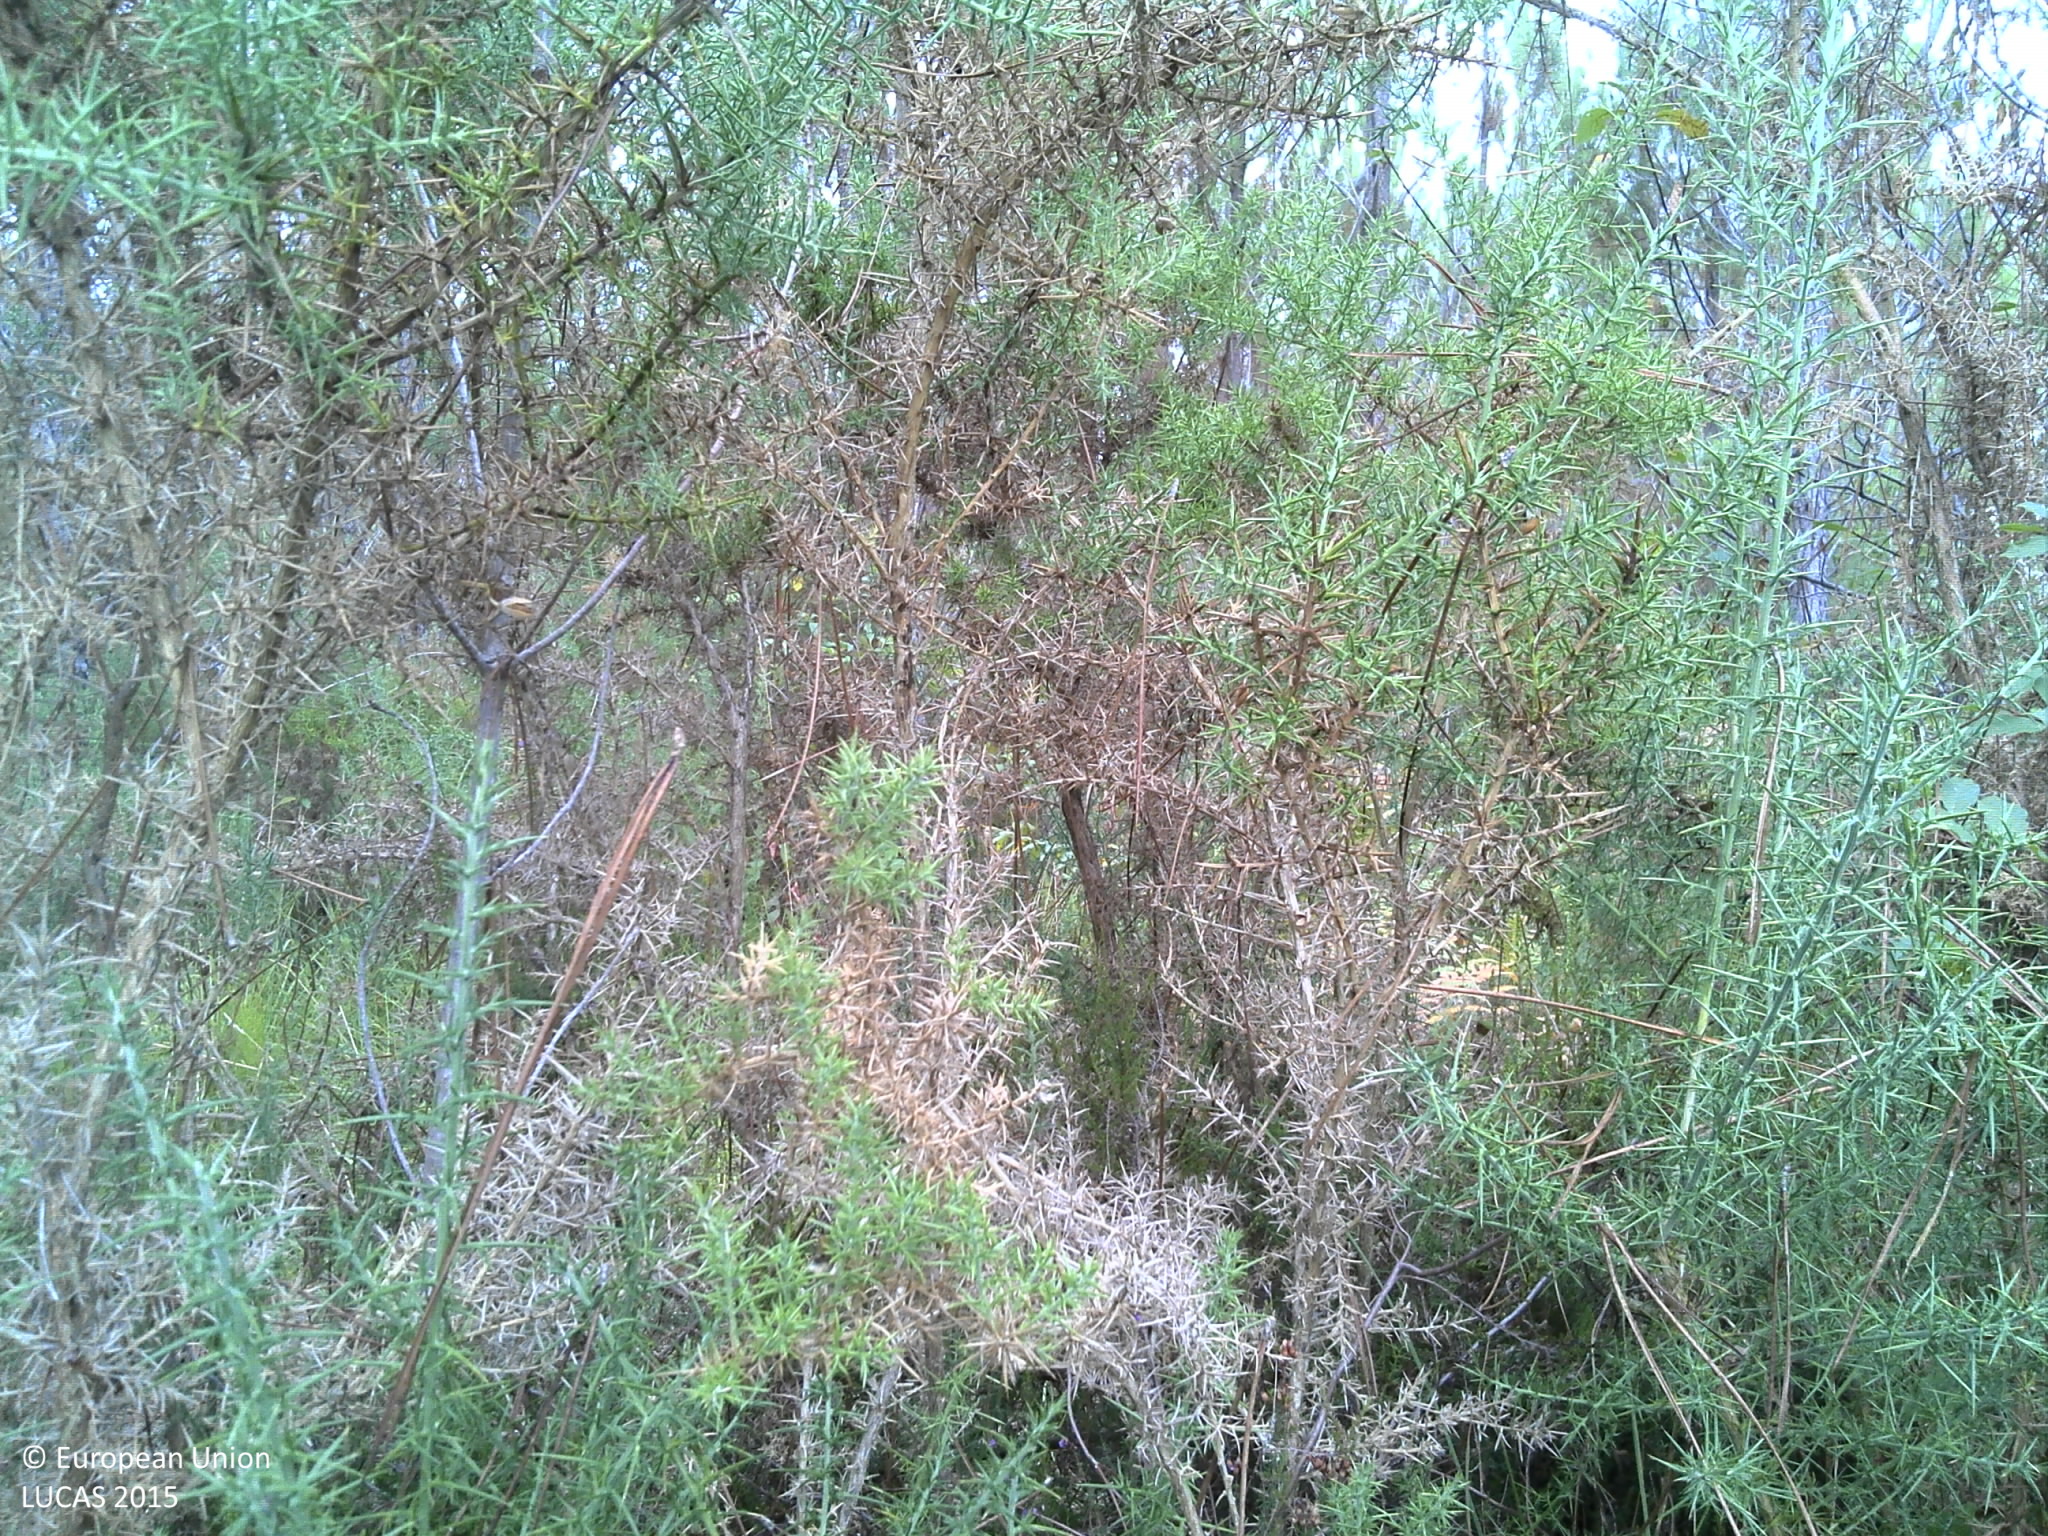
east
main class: Woodland
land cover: Pine dominated coniferous woodland
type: coniferous forest of the mediterranean region
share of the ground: > 75 %
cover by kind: coniferous forest trees 60 %, shrubs 30 %, herbaceous plants 5 %, lichens and mosses 5 %
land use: Forestry
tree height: > 5 m
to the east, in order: Pine dominated coniferous woodland; Spontaneously vegetated surfaces
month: August
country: FR
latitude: 44.6625
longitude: -0.9303
